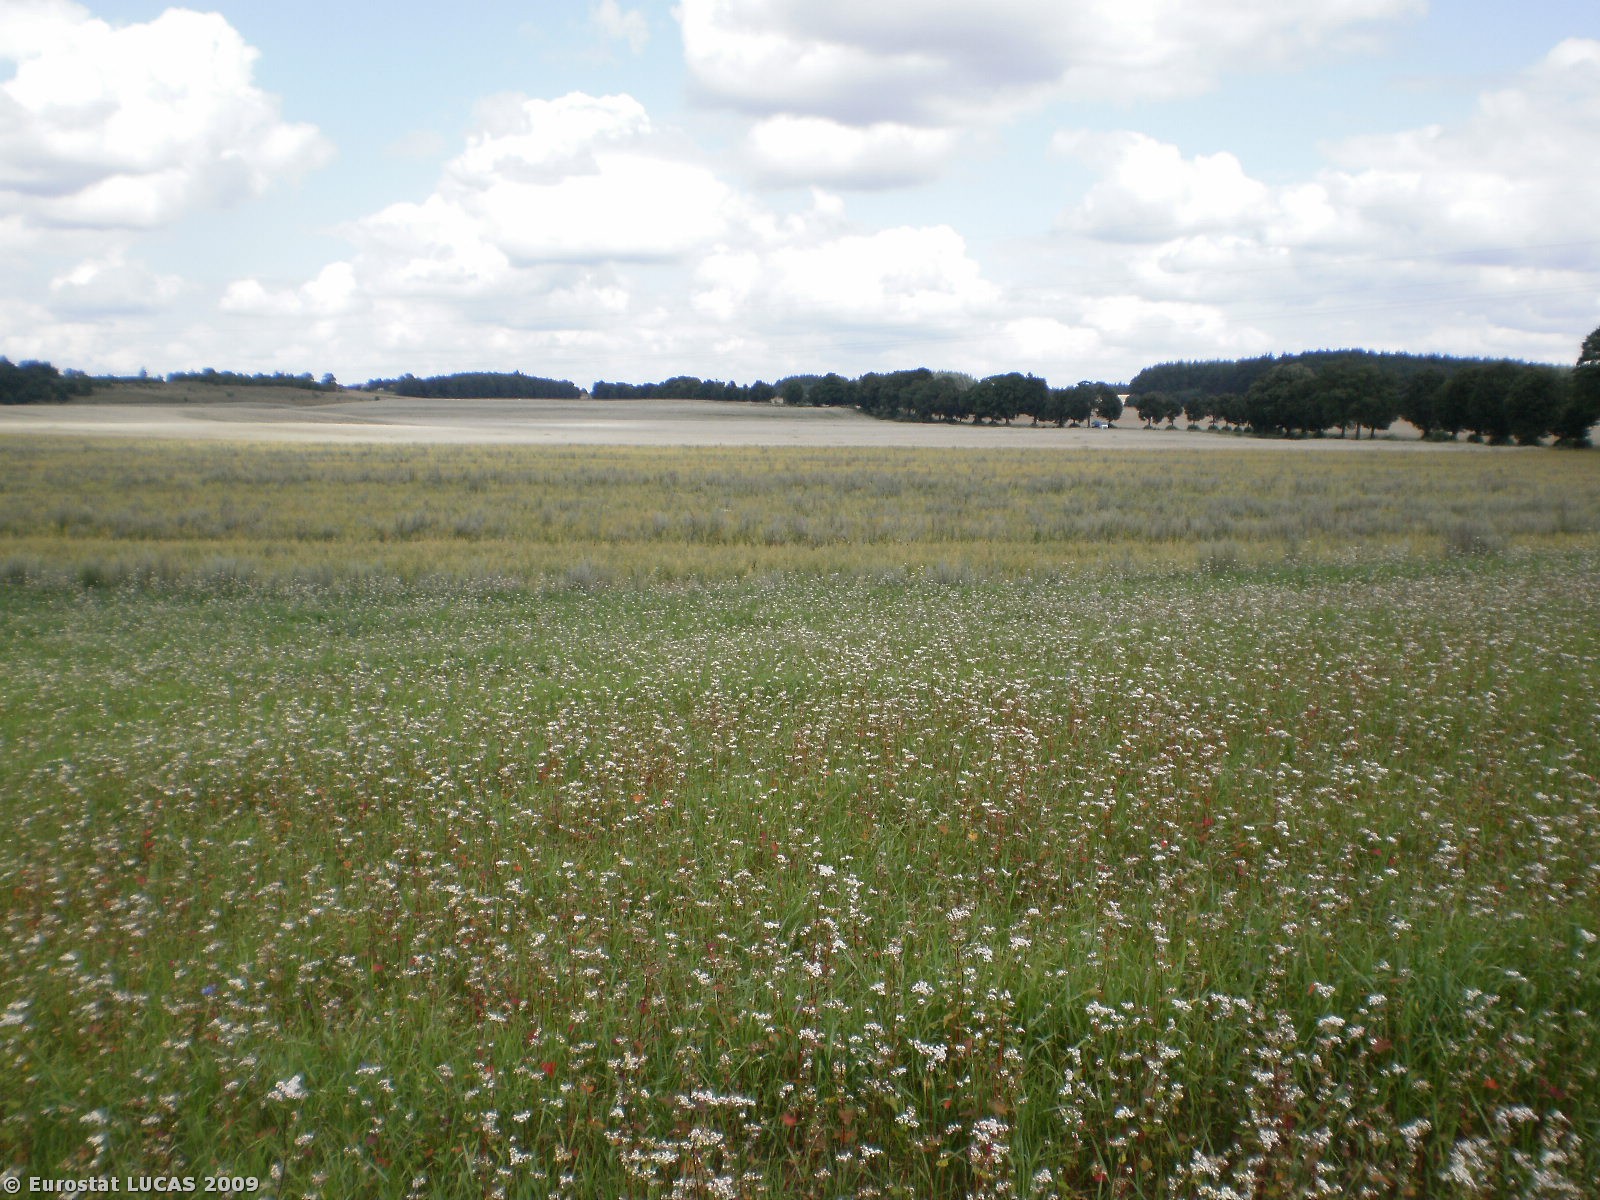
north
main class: Cropland
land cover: Other cereals
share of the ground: > 75 %
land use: Agriculture (excluding fallow land and kitchen gardens)
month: July
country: PL
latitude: 53.4239
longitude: 20.4047
